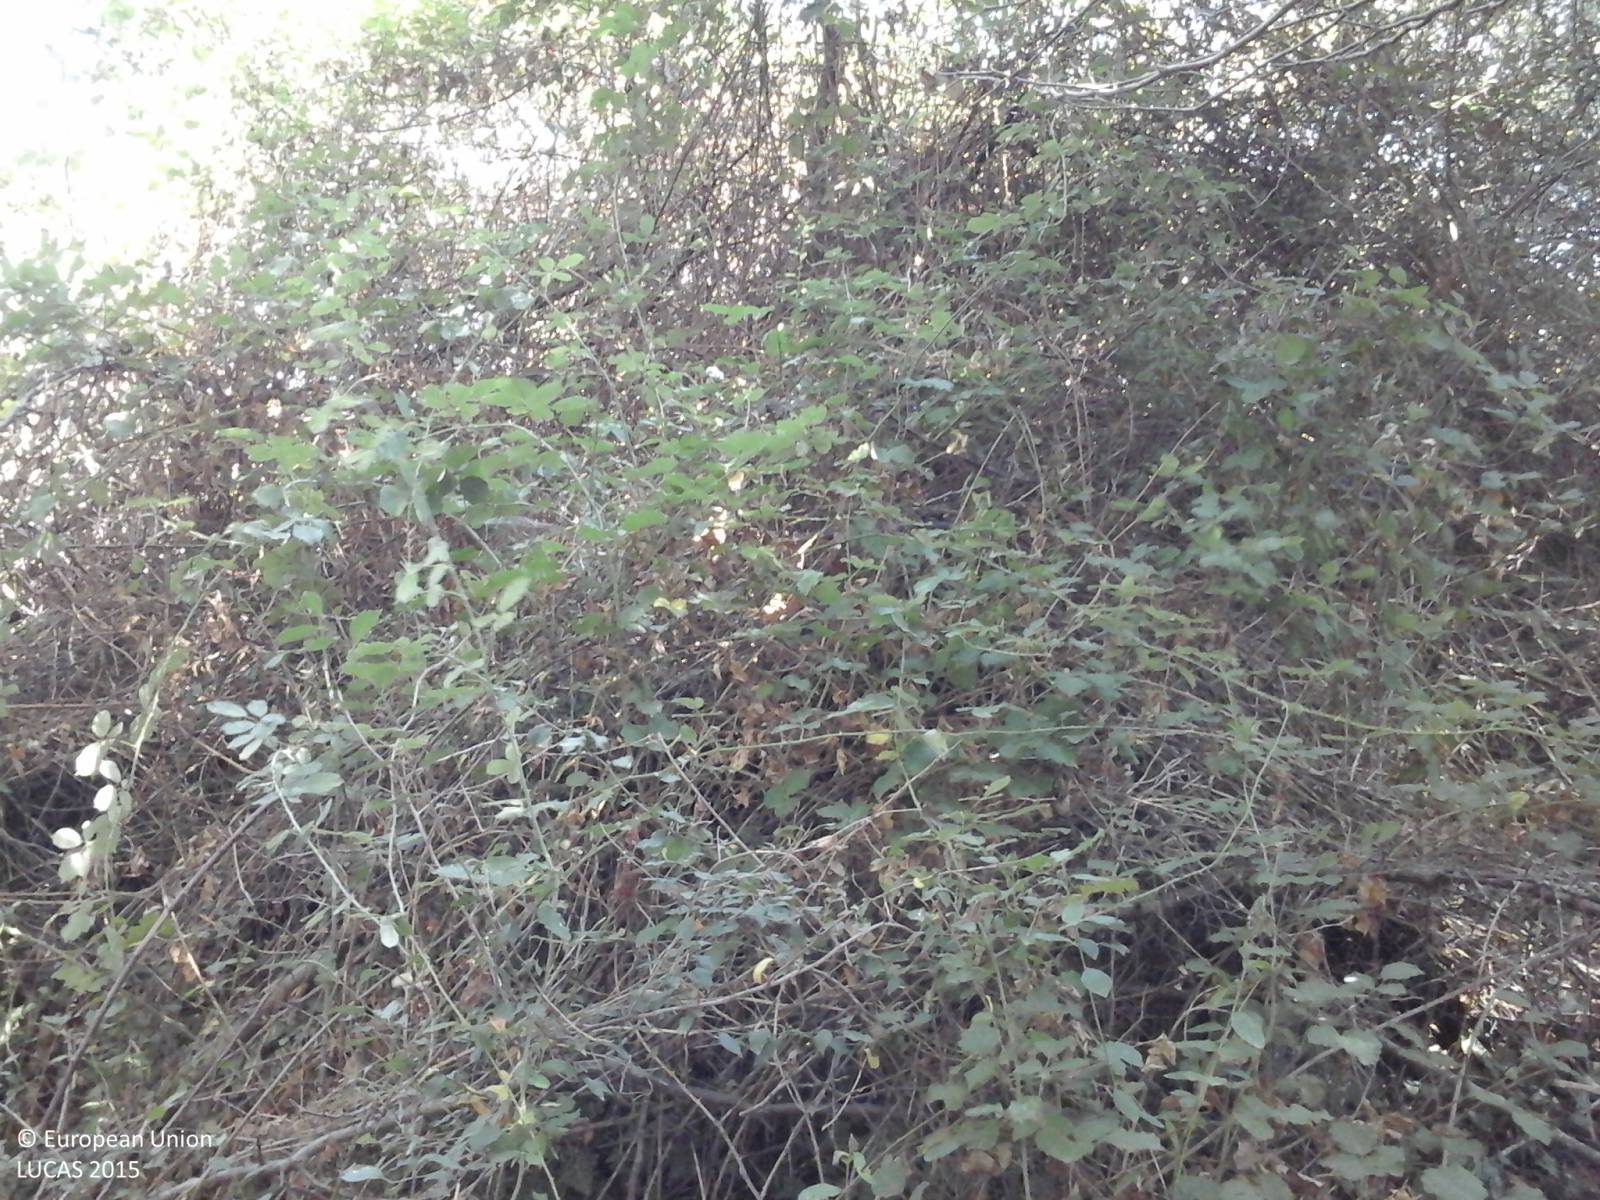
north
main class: Woodland
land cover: Broadleaved woodland
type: acidophilous oak and oak-birch forest
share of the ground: 10 - 25 %
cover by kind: unconsolidated bare surface 50 %, herbaceous plants 25 %, shrubs 15 %, broadleaved forest trees 10 %
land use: Semi-natural and natural areas not in use
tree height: > 5 m
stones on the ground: < 10 %
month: August
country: IT
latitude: 40.9876
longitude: 9.1600
